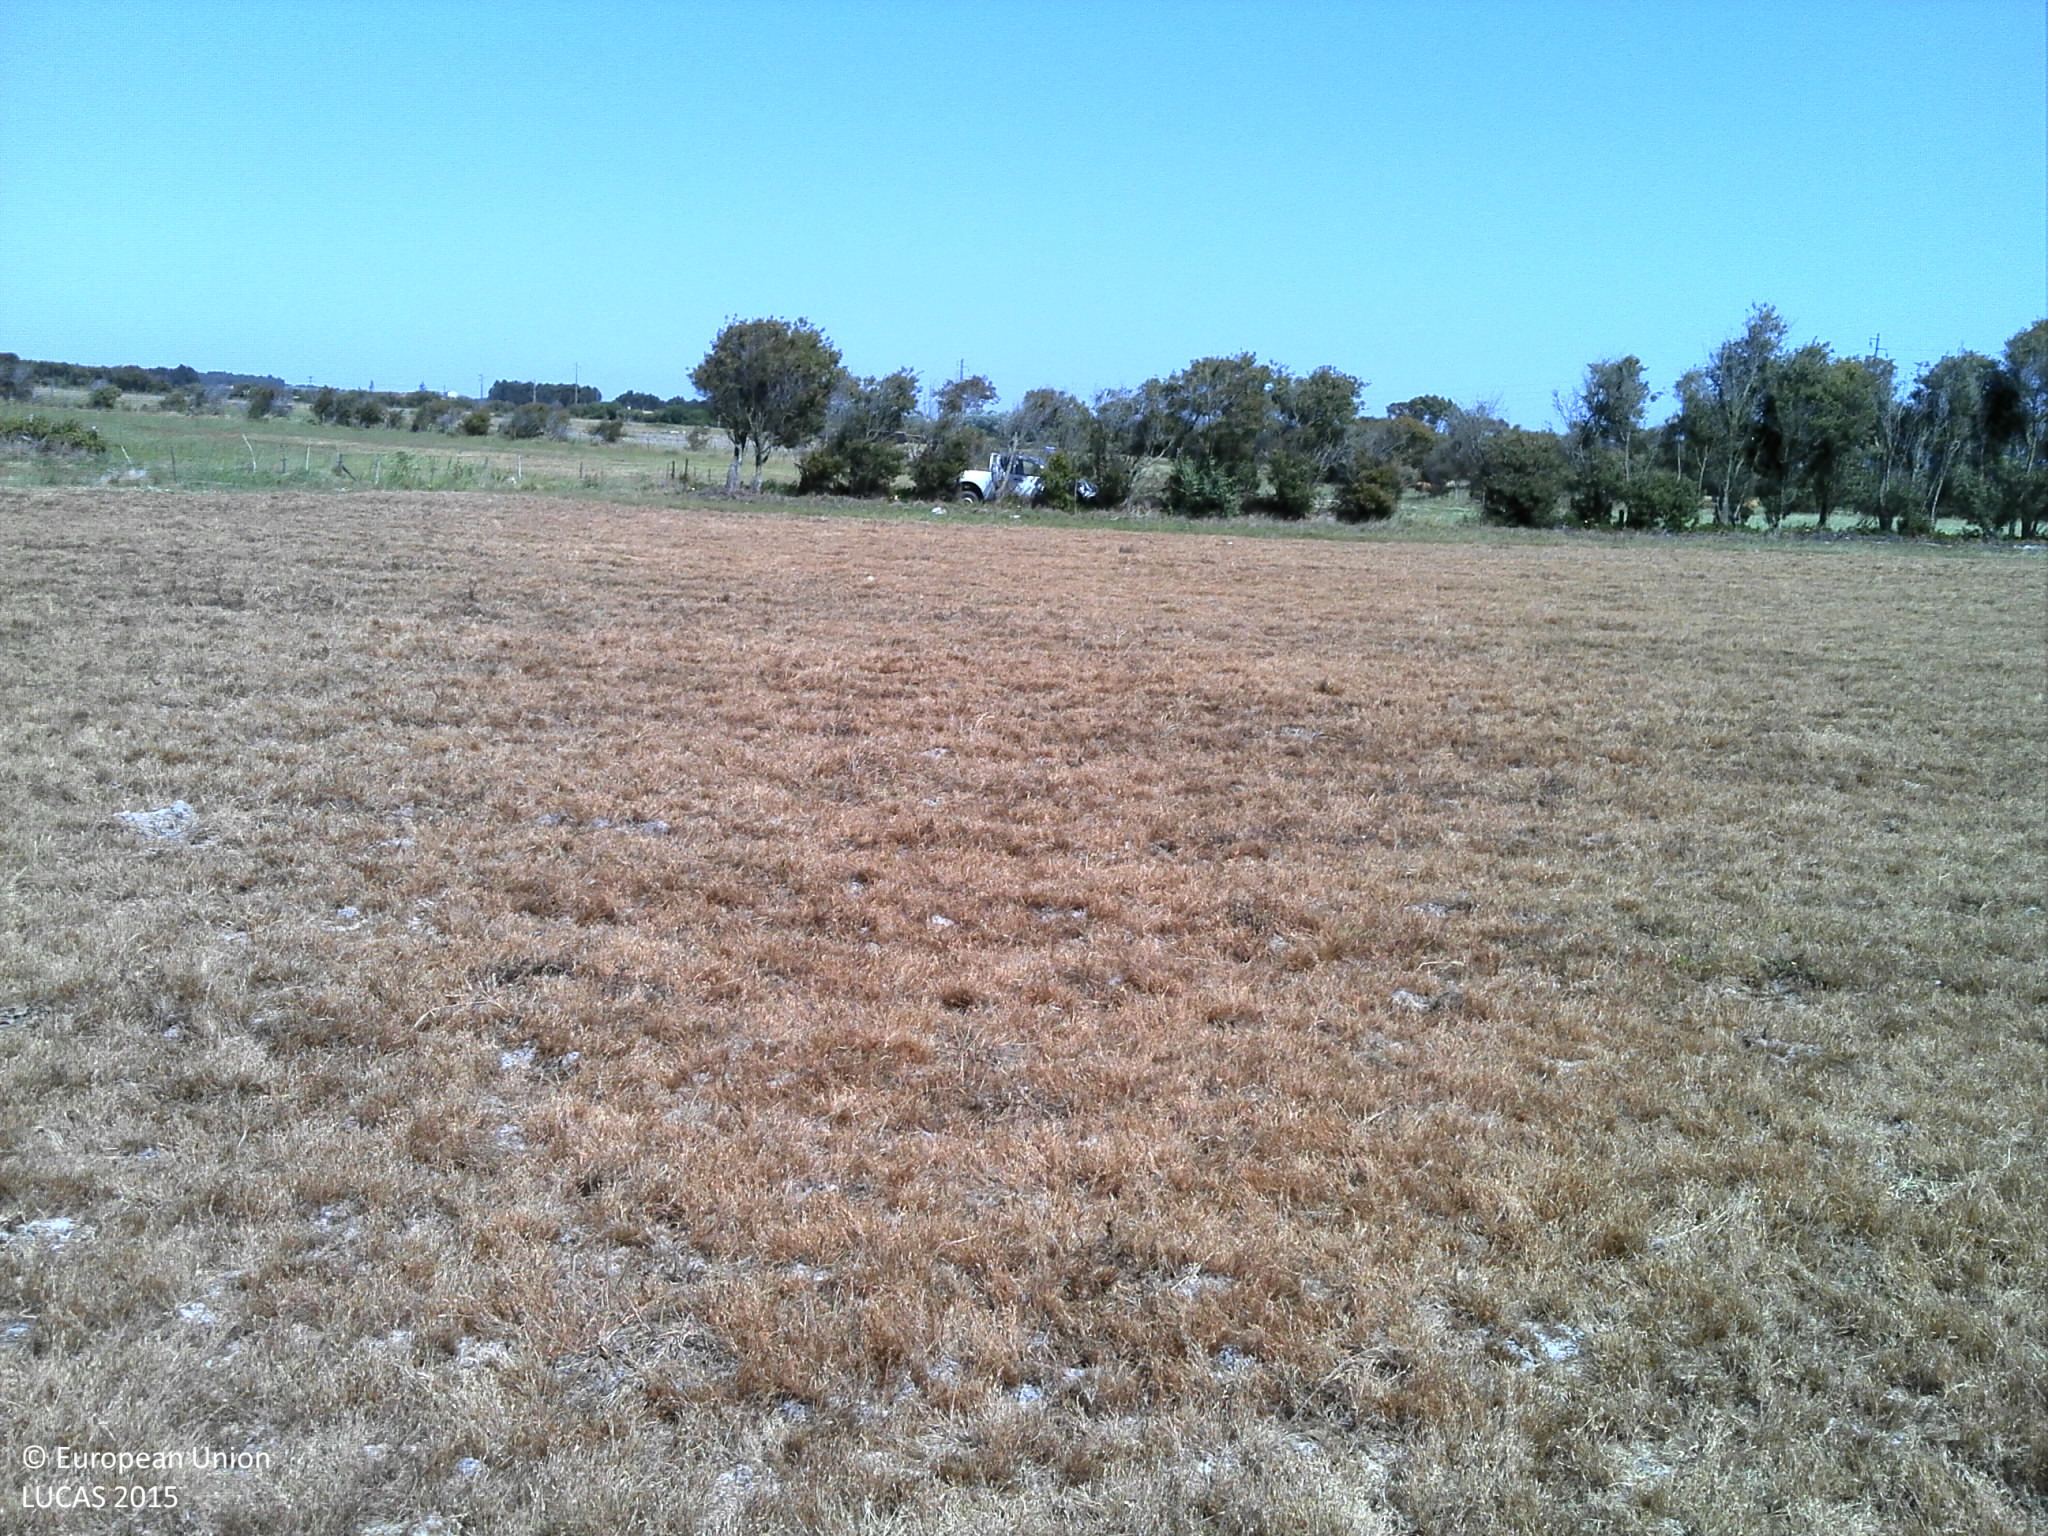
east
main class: Grassland
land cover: Grassland without tree/shrub cover
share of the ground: > 75 %
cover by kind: herbaceous plants 80 %, consolidated bare surface 20 %
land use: Agriculture (excluding fallow land and kitchen gardens)
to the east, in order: Grassland without tree/shrub cover; Fences; Ditches and canals; Fences; Grassland without tree/shrub cover; Fences; Tracks; Abandoned hedges; Fences; Grassland without tree/shrub cover; Fences; Grassland without tree/shrub cover
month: May
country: PT
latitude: 37.5298
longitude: -8.7679
